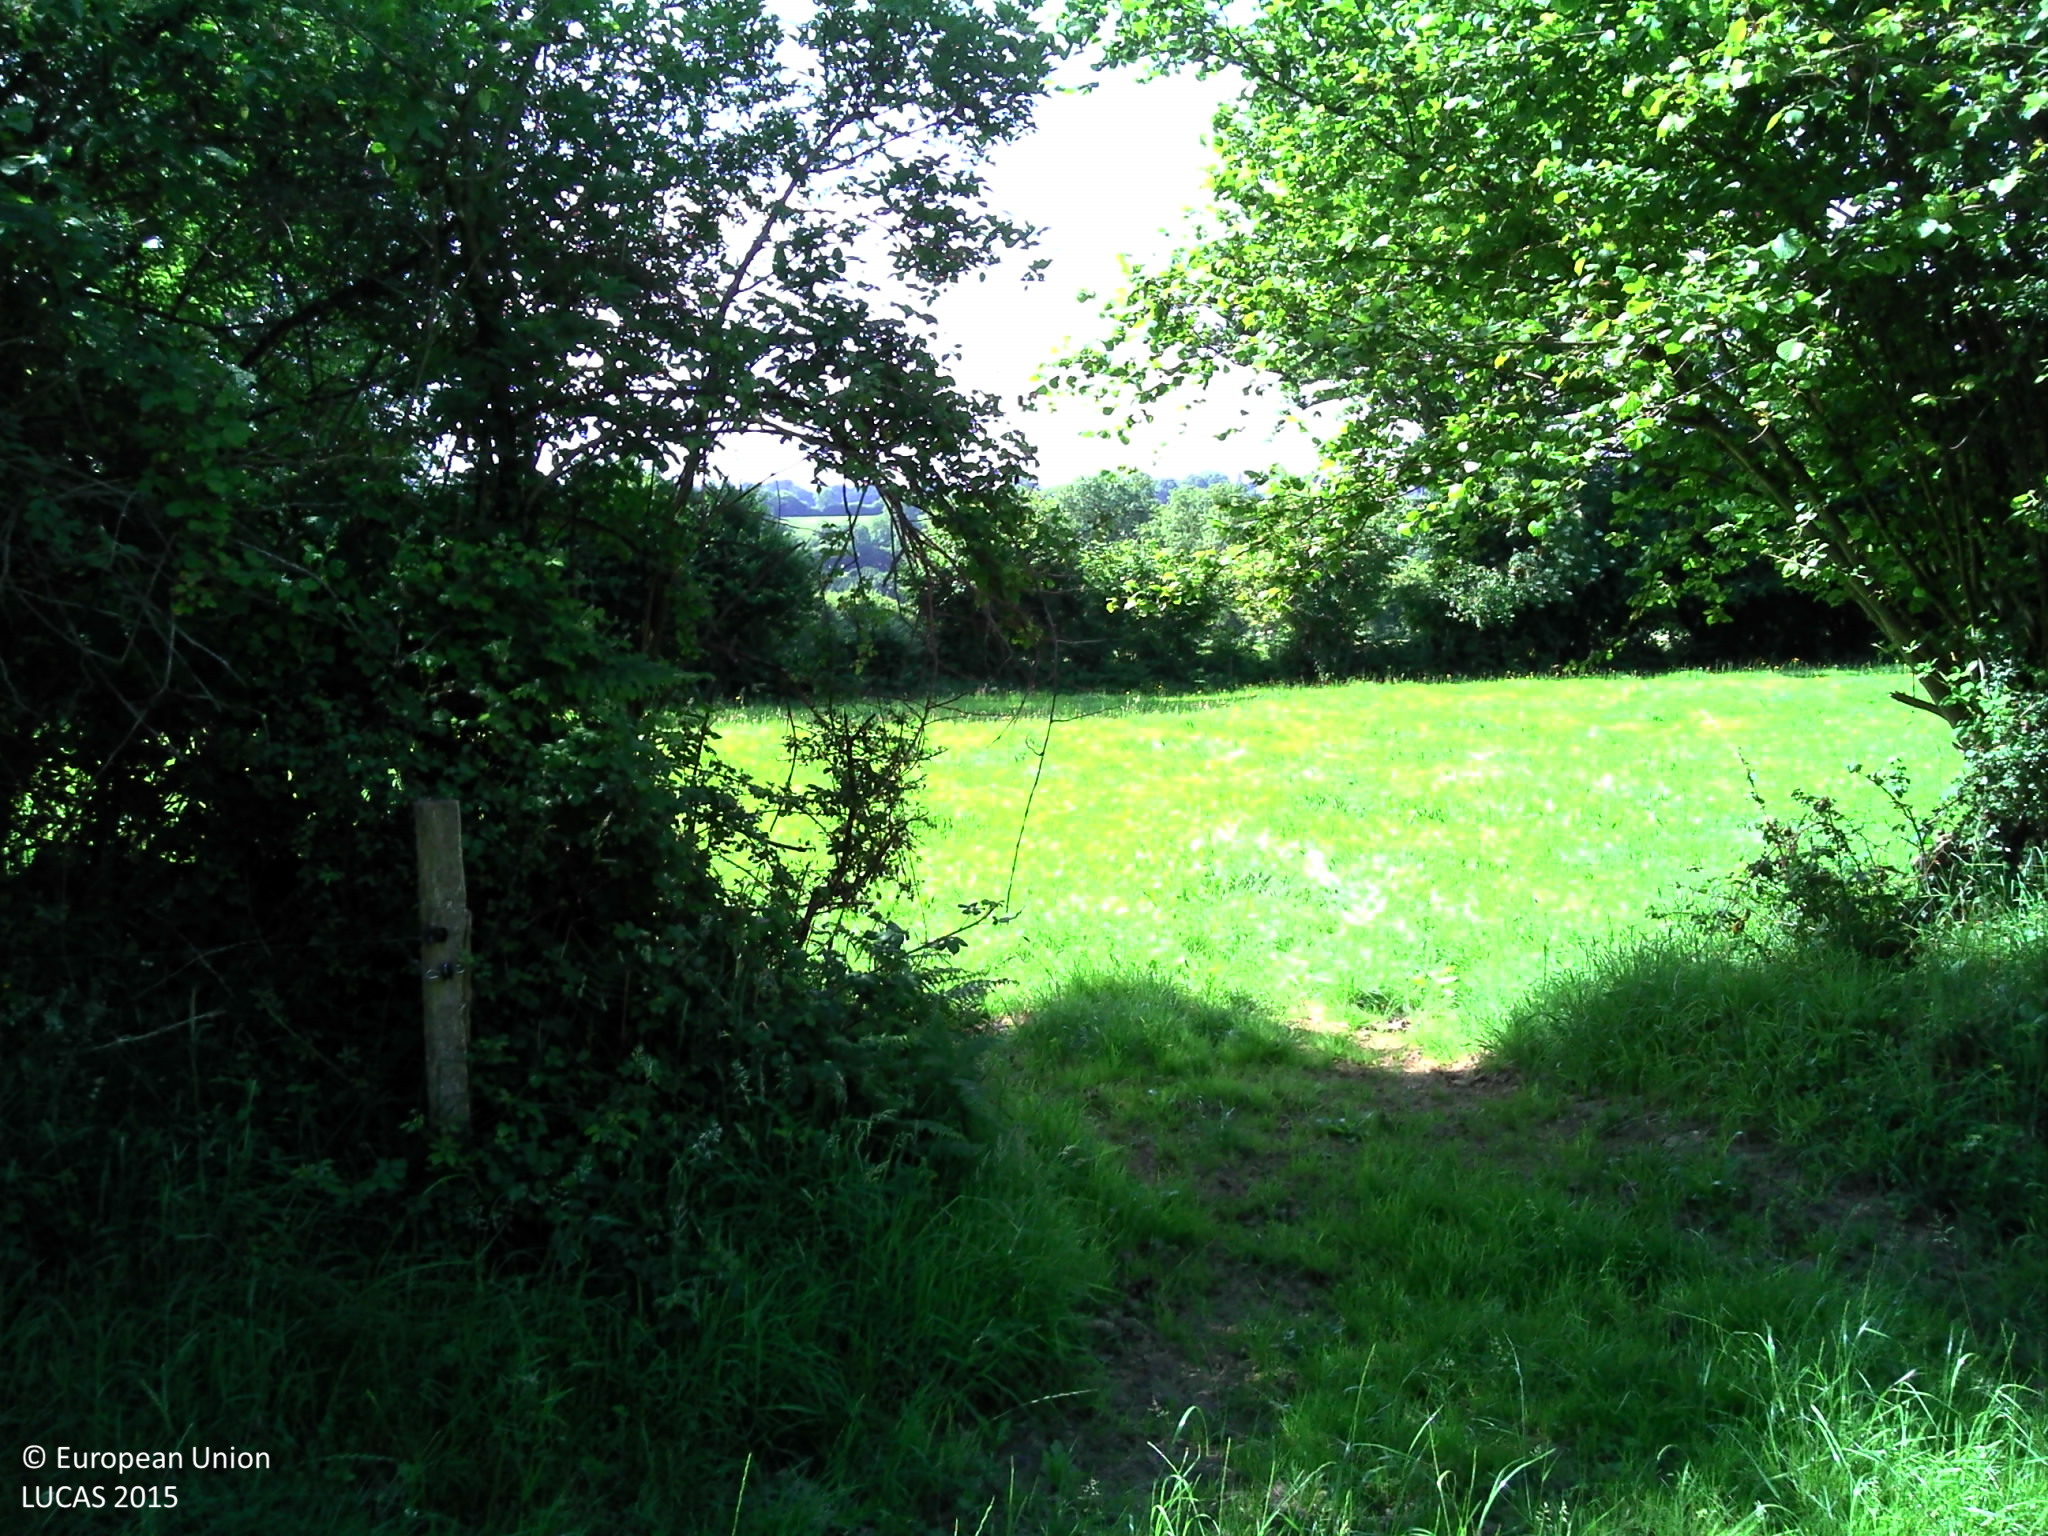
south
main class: Grassland
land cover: Grassland with sparse tree/shrub cover
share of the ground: > 75 %
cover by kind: herbaceous plants 95 %, broadleaved forest trees 5 %
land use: Agriculture (excluding fallow land and kitchen gardens)
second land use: Forestry
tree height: > 5 m
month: June
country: FR
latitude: 49.0921
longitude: -1.3165
